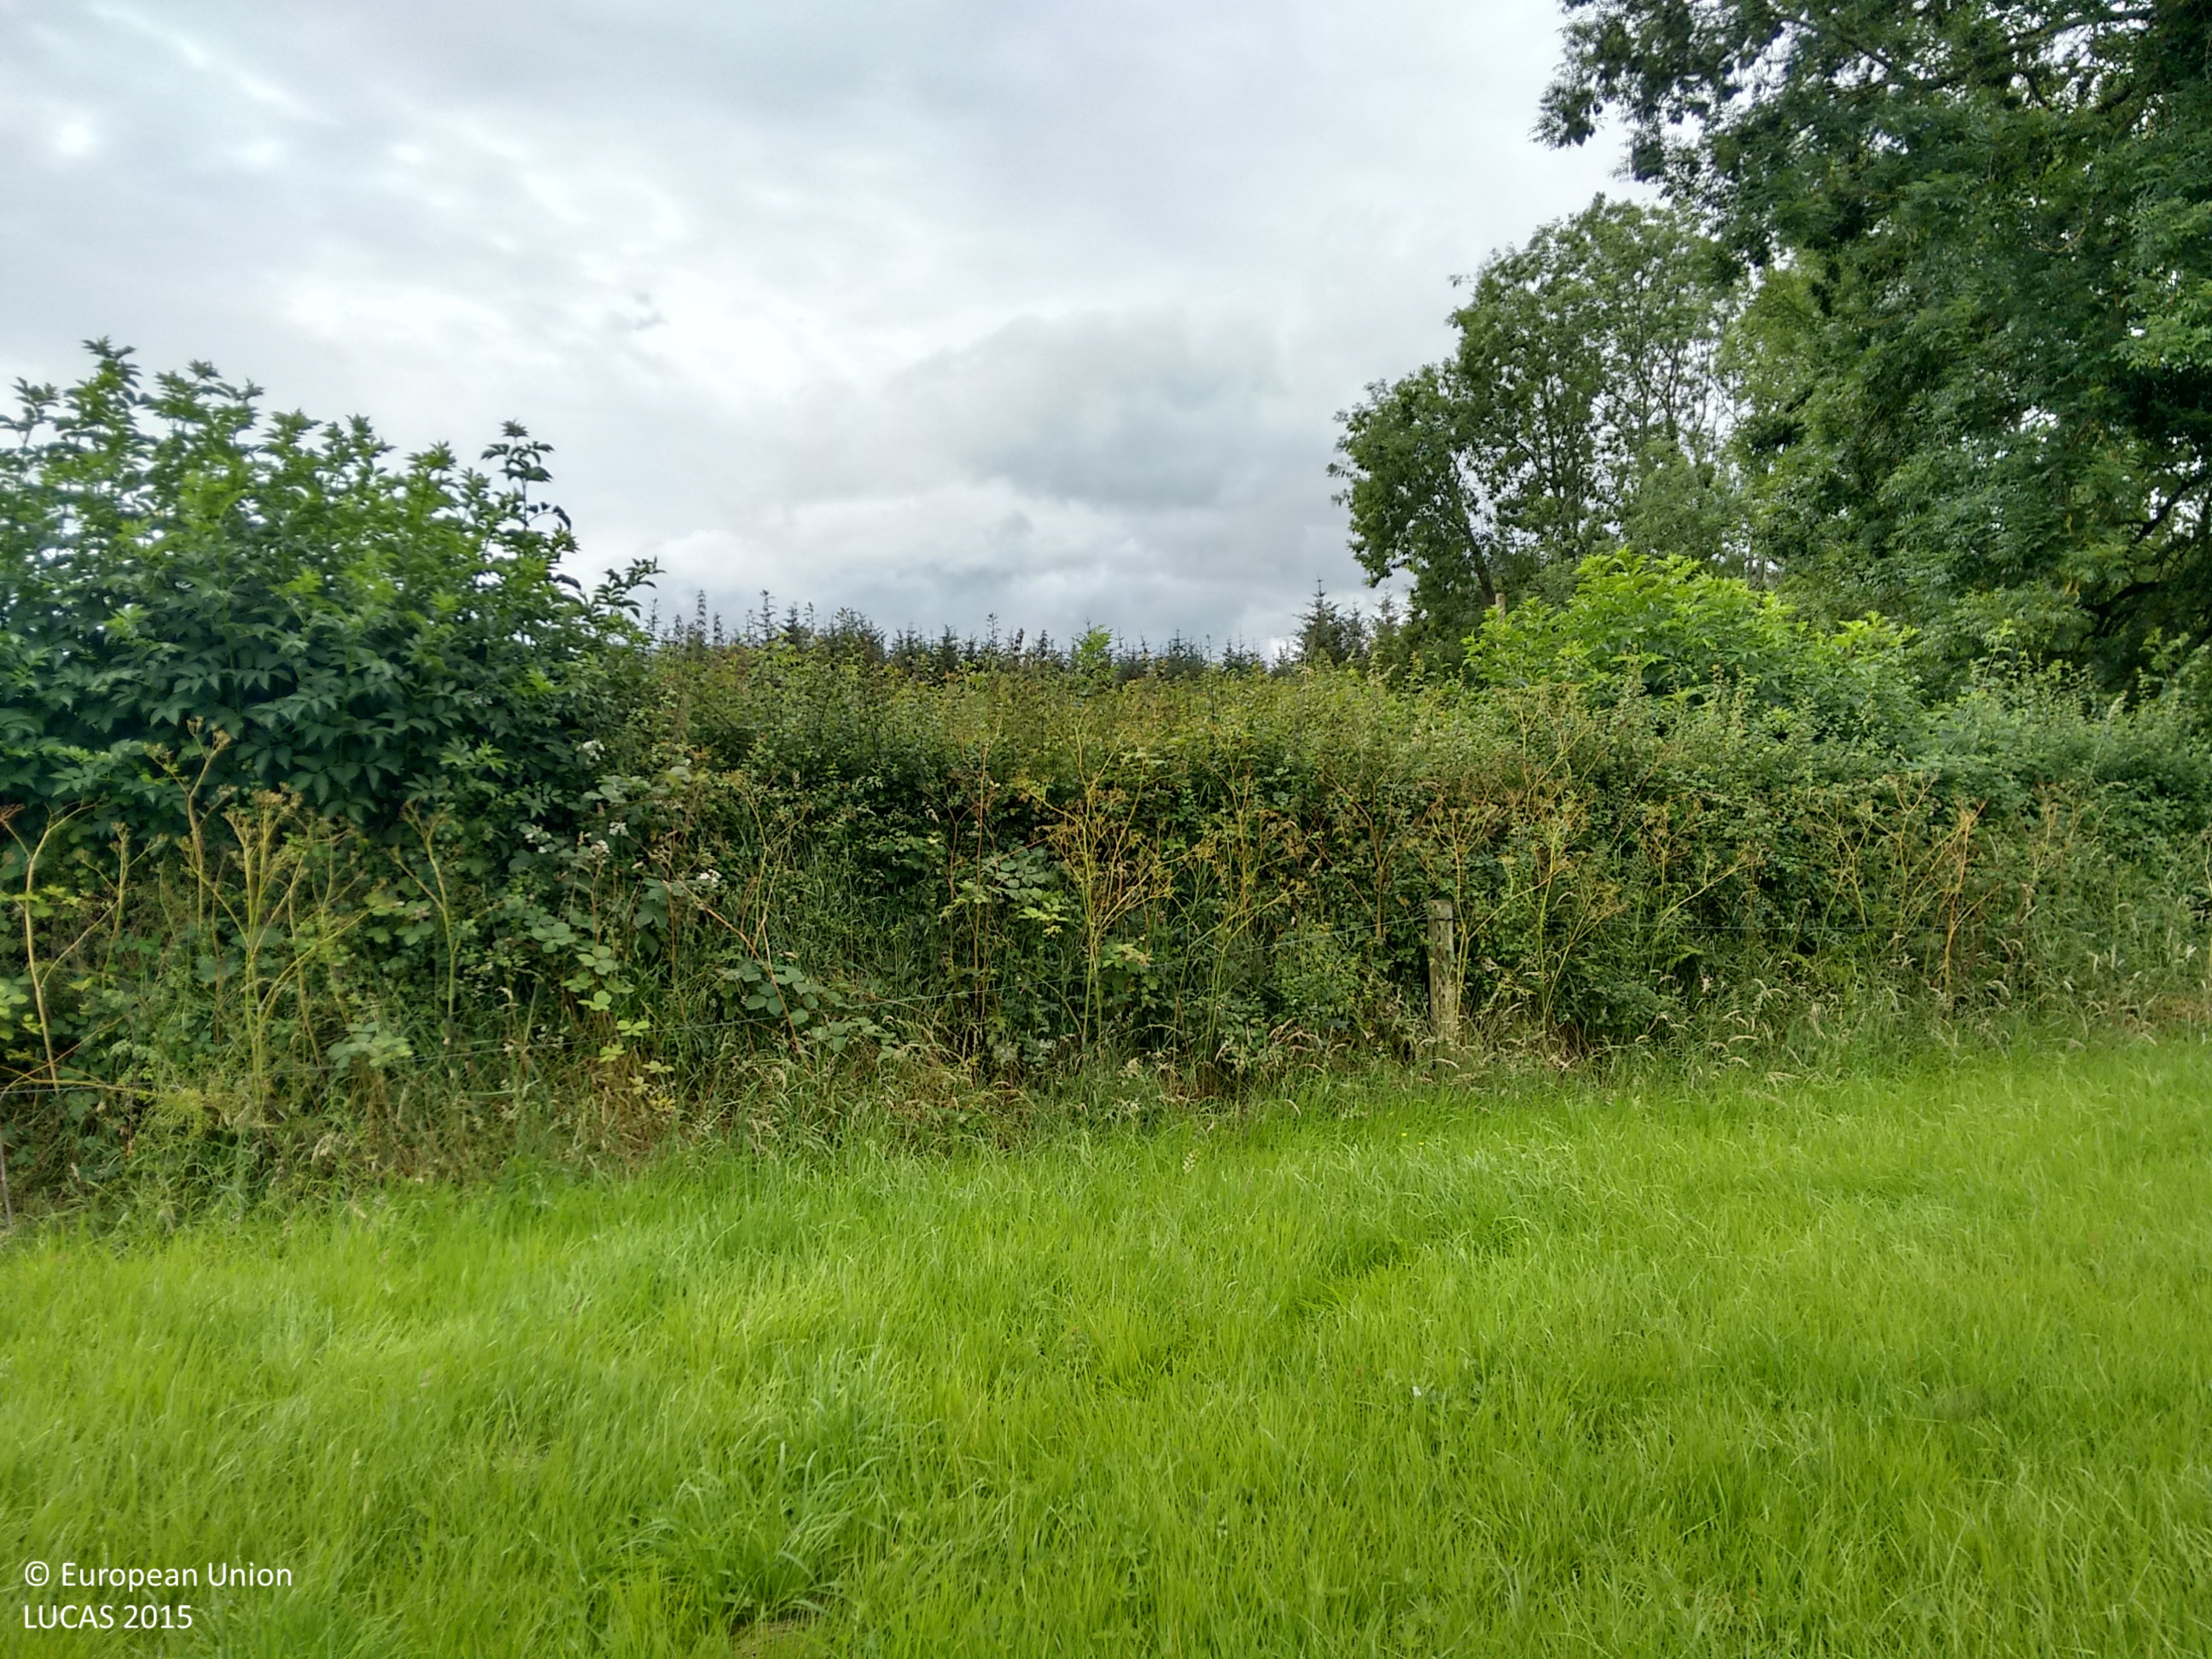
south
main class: Grassland
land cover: Grassland without tree/shrub cover
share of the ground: > 75 %
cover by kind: herbaceous plants 100 %
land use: Agriculture (excluding fallow land and kitchen gardens)
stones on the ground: < 10 %
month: July
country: IE
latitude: 52.5994
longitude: -7.3239
